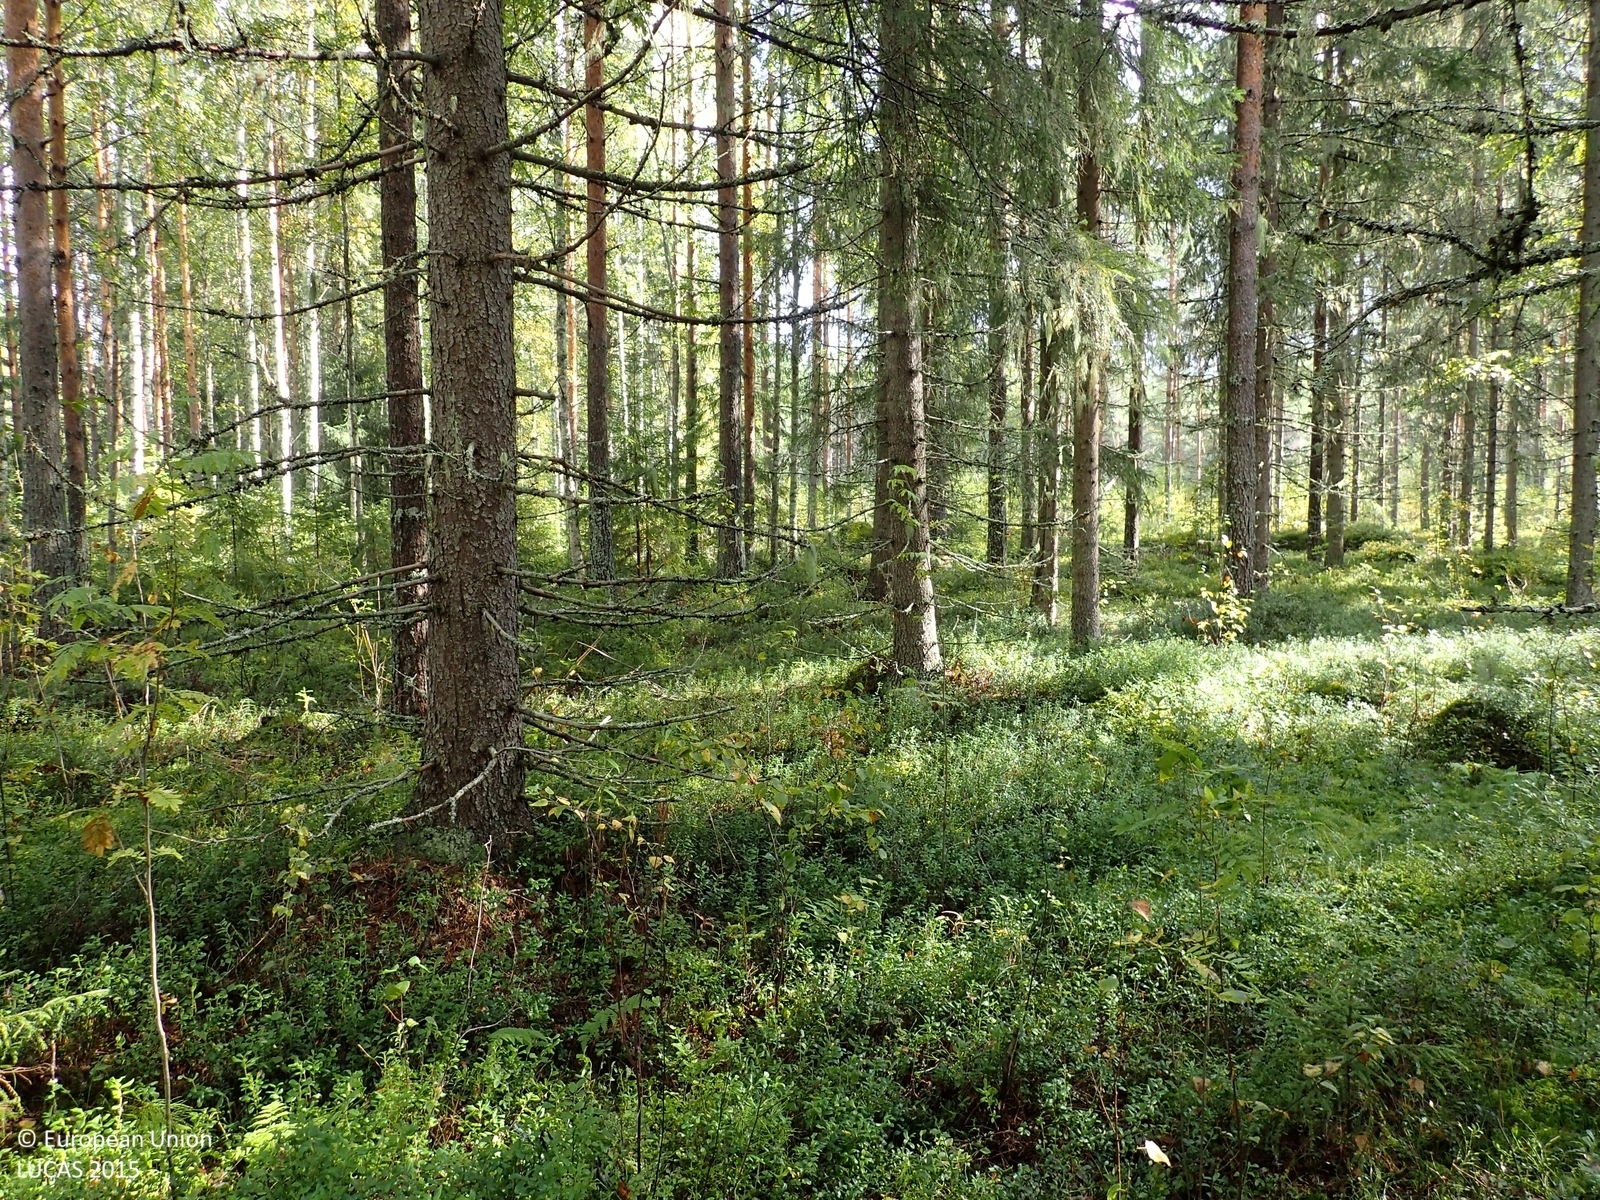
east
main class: Woodland
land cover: Other mixed woodland
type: boreal forest
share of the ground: > 75 %
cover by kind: coniferous forest trees 55 %, broadleaved forest trees 20 %, shrubs 20 %, lichens and mosses 5 %
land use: Forestry
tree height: > 5 m
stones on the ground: < 10 %
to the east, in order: Other mixed woodland; Ditches and canals; Other mixed woodland; Ditches and canals; Spontaneously vegetated surfaces; Other coniferous woodland; Ditches and canals; Grassland without tree/shrub cover
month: September
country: FI
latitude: 63.2240
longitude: 25.8507
